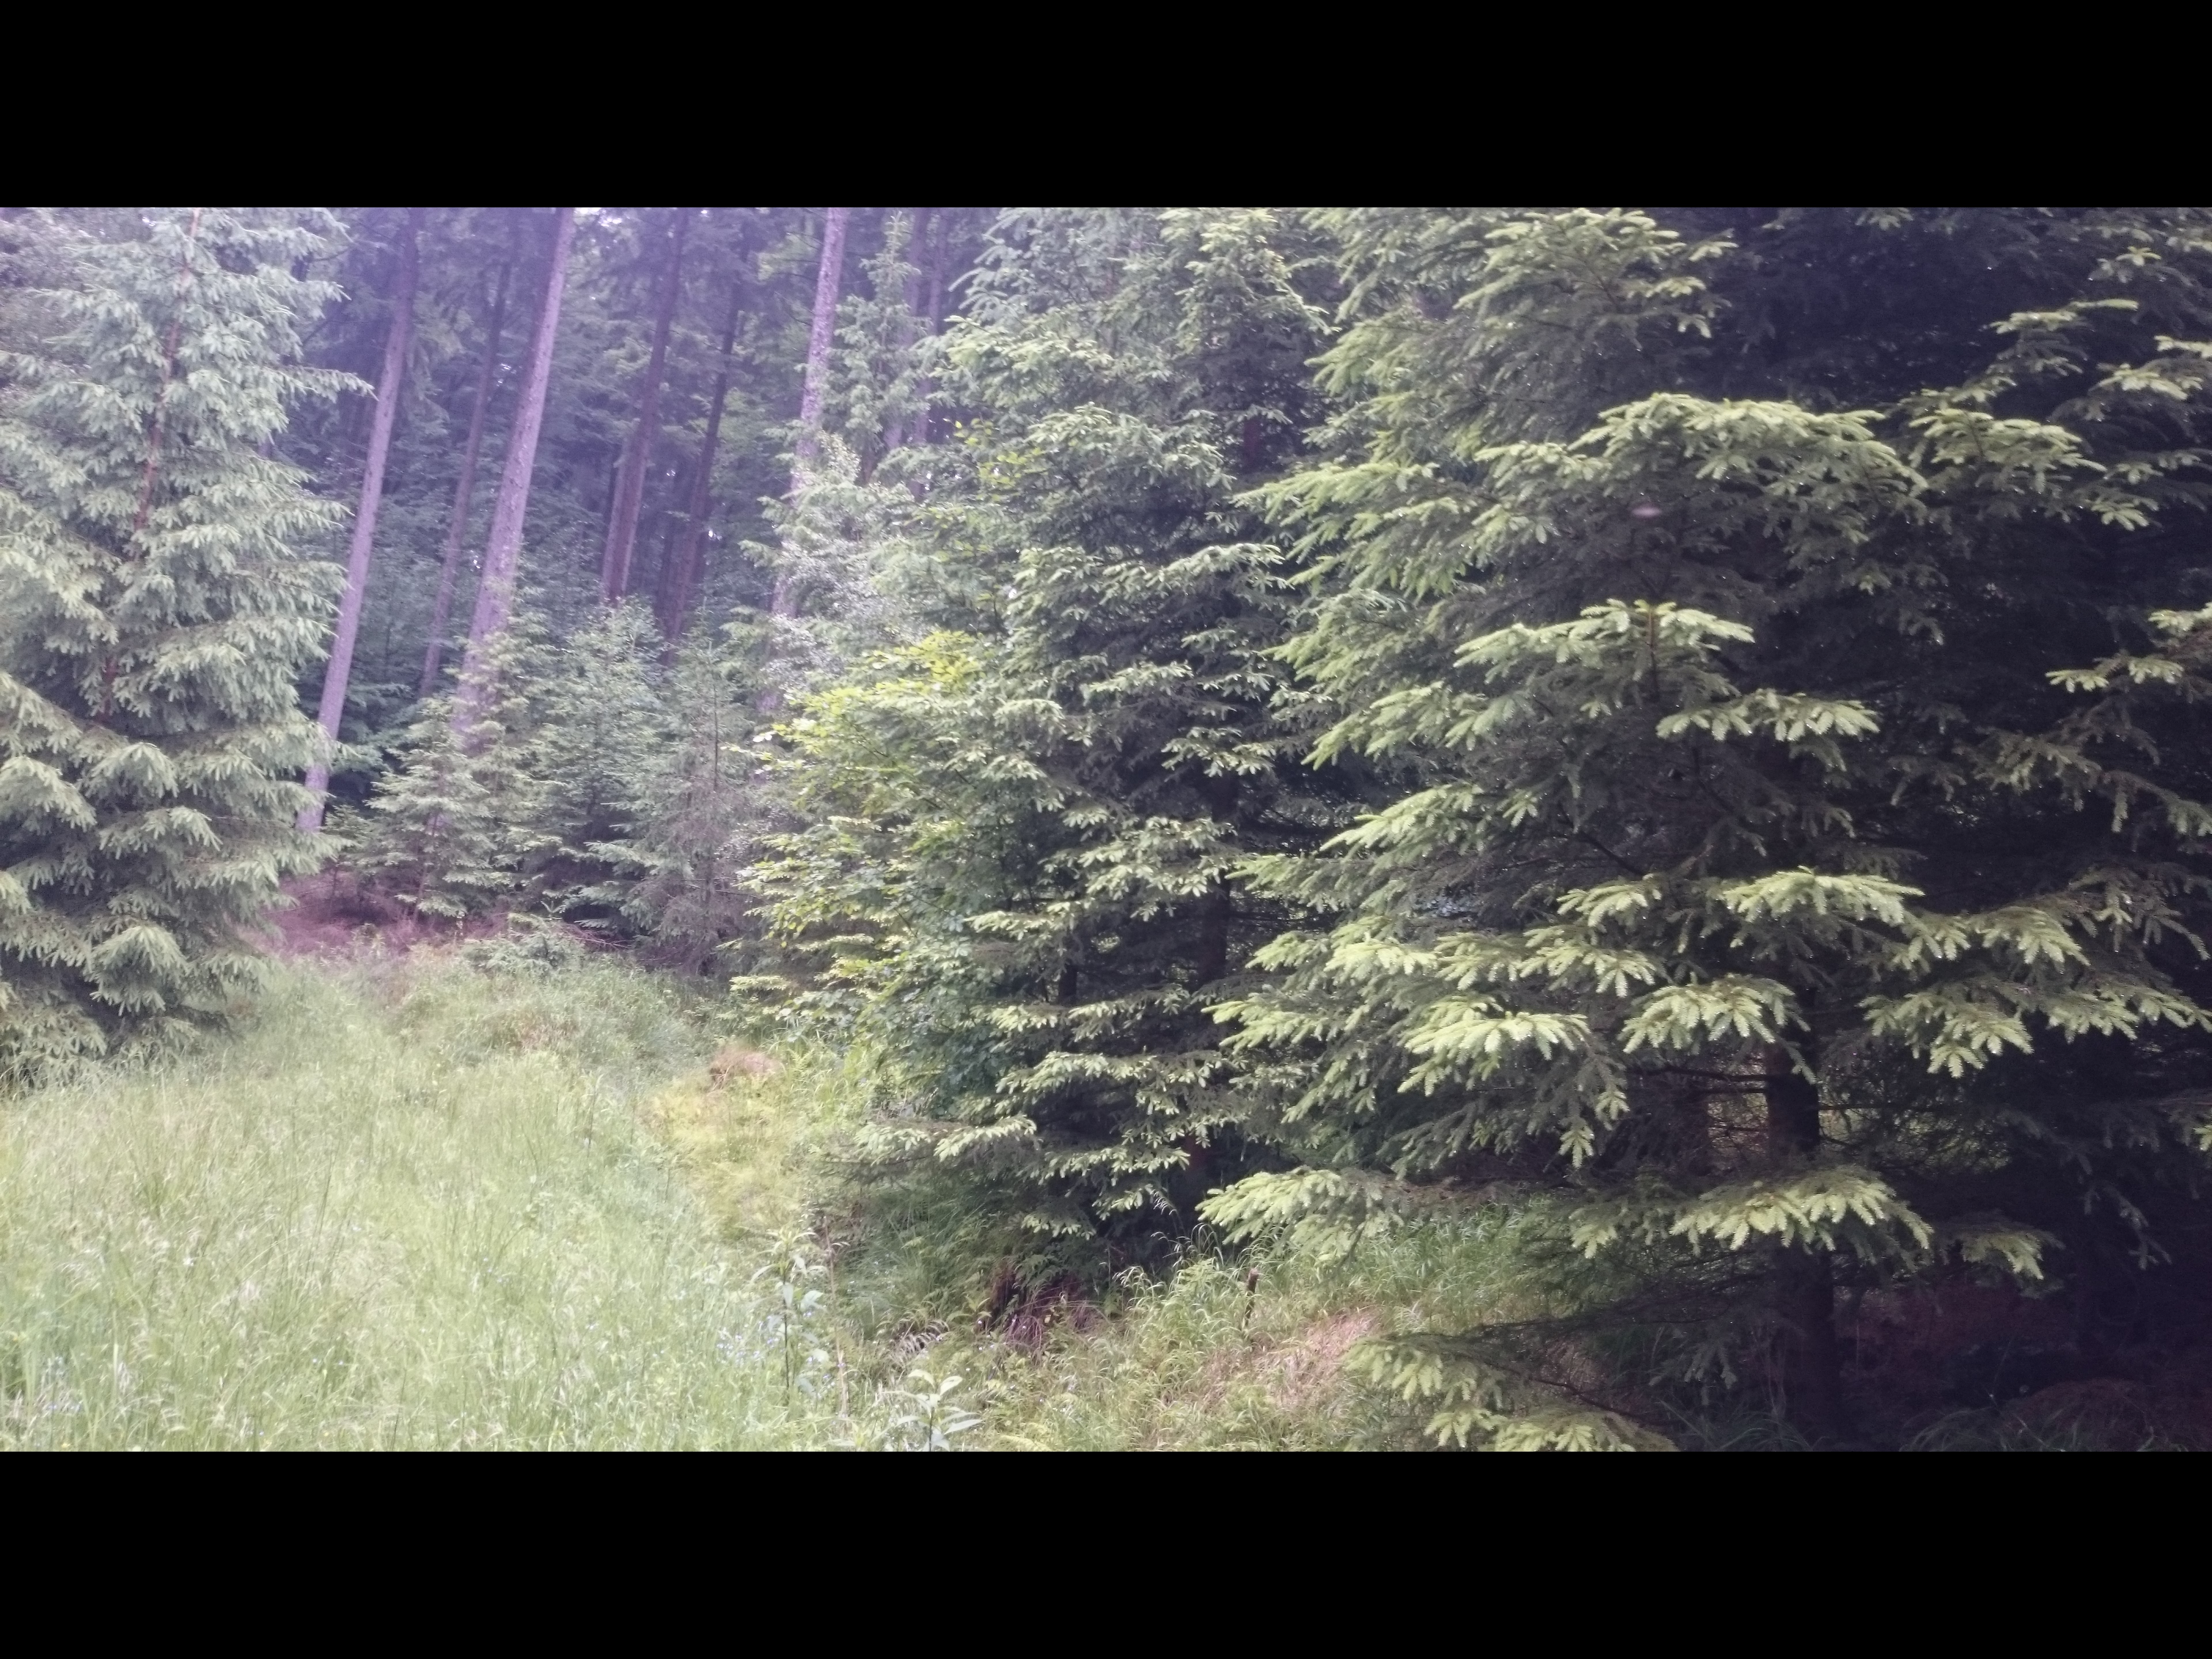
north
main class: Woodland
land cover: Spruce dominated coniferous woodland
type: hemiboreal forest and nemoral coniferous forest and mixed broadleaved-coniferous forest
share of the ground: > 75 %
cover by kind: coniferous forest trees 80 %, shrubs 10 %, unconsolidated bare surface 10 %
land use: Forestry
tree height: > 5 m
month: June
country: AT
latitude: 48.5940
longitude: 14.6517
